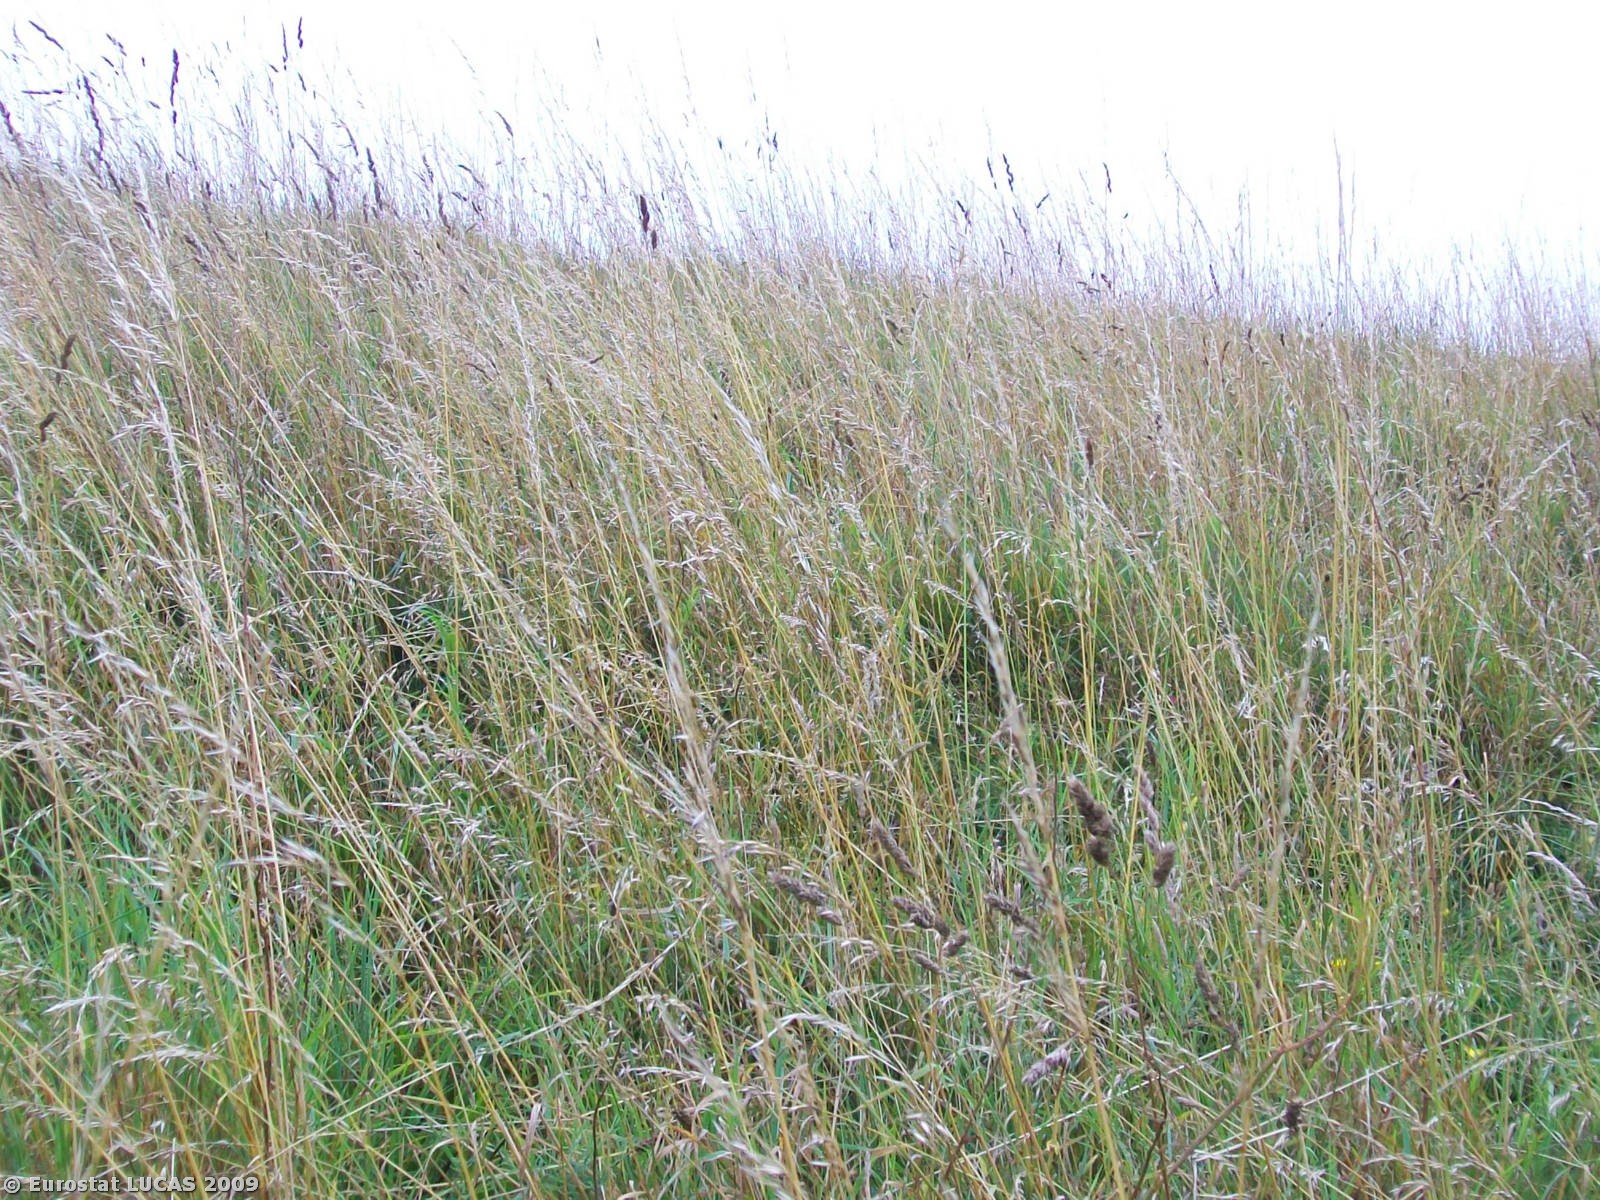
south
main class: Grassland
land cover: Grassland without tree/shrub cover
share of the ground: > 75 %
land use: Agriculture (excluding fallow land and kitchen gardens)
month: July
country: GB
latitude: 50.7662
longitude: -2.6736
